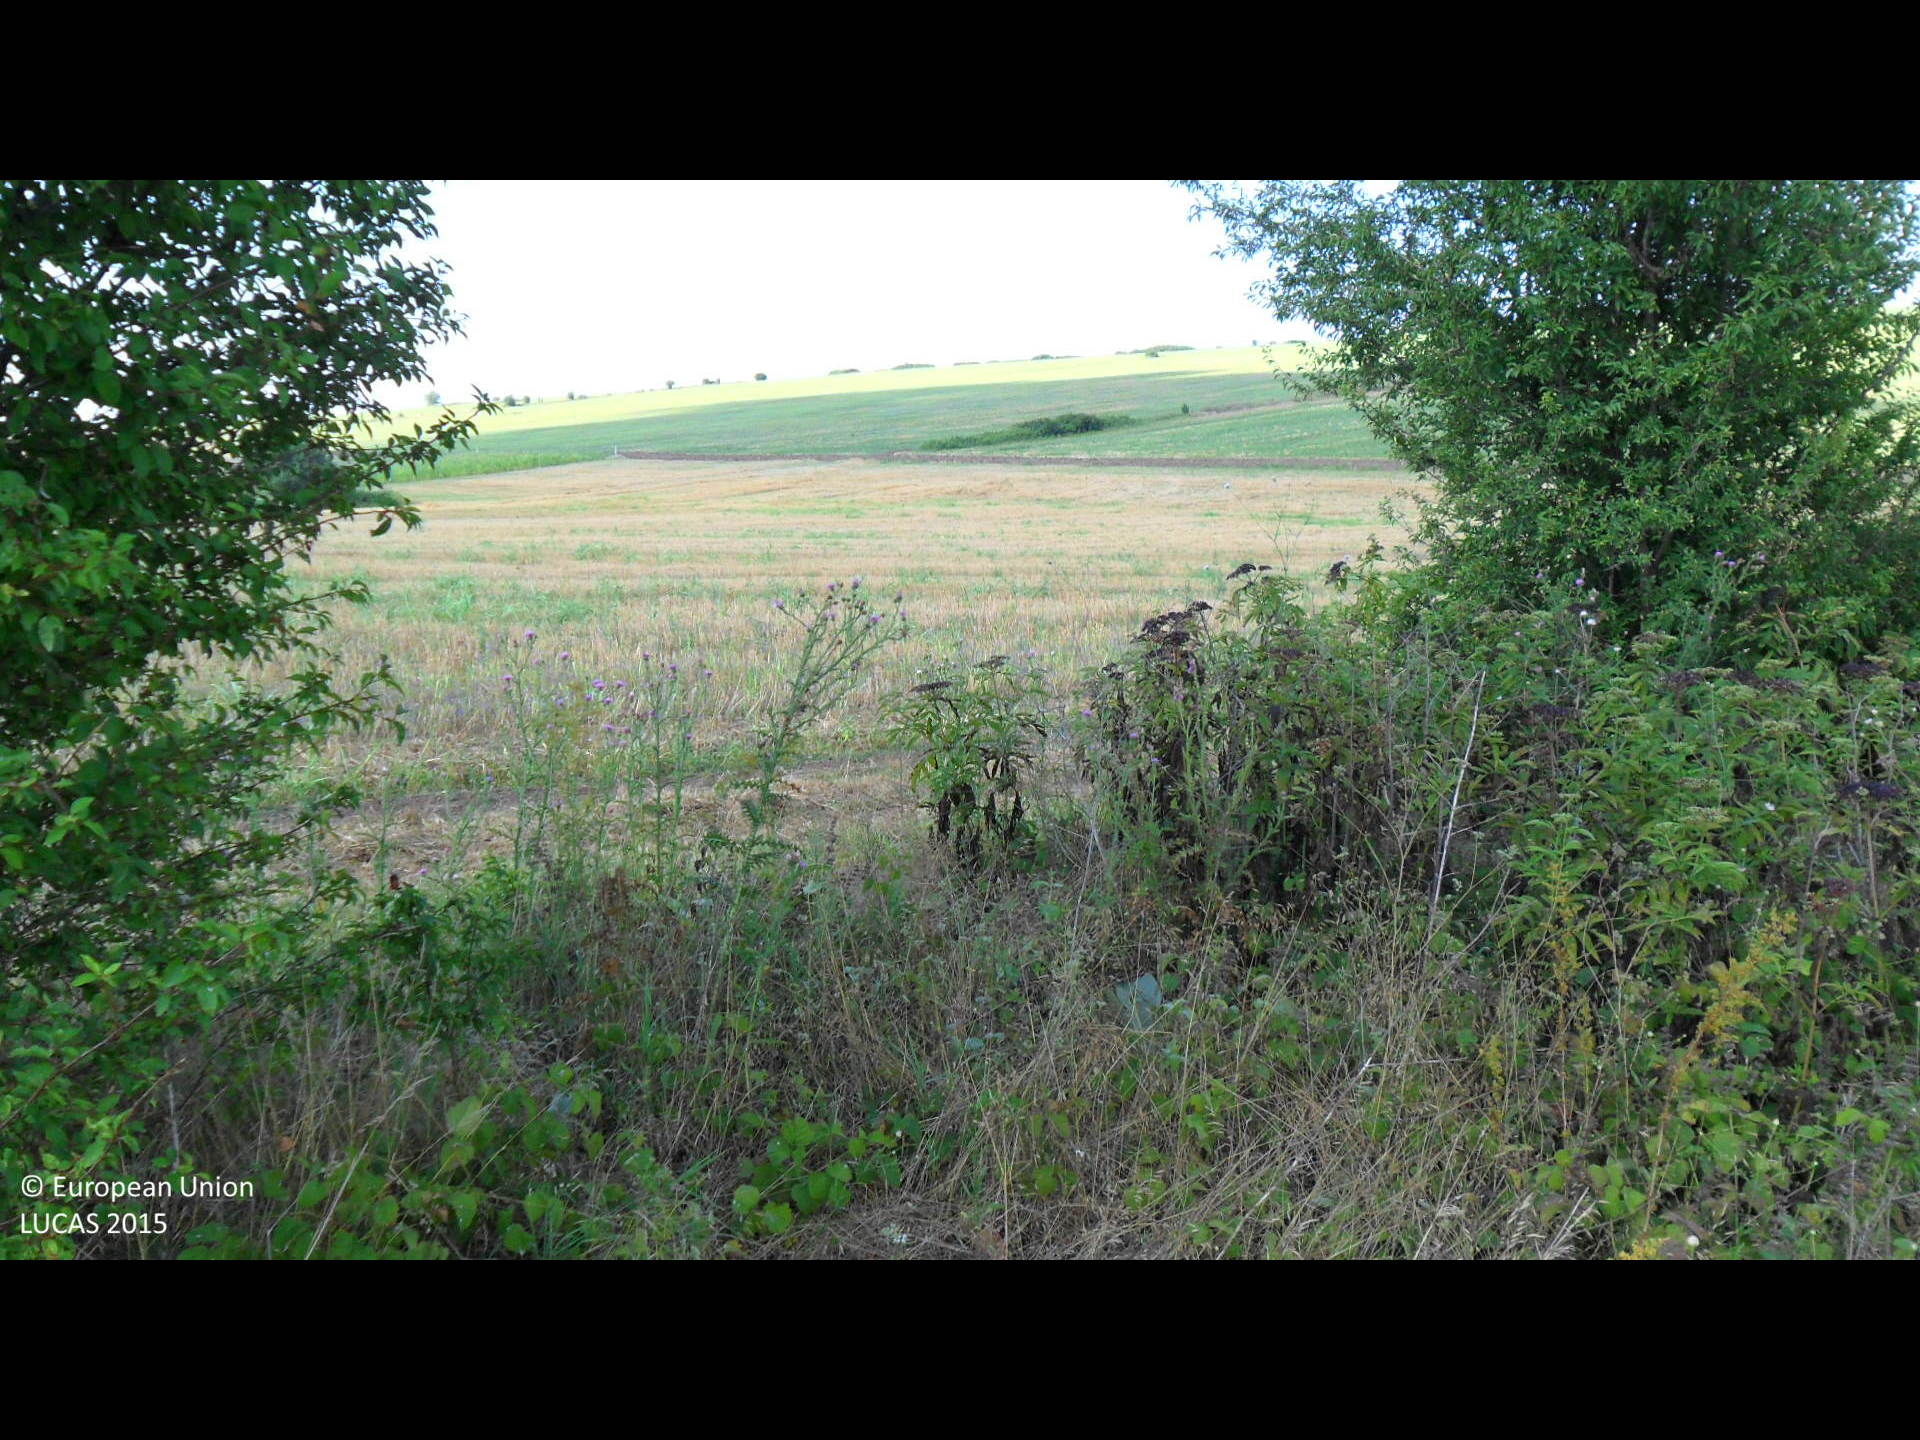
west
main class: Cropland
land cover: Sunflower
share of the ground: > 75 %
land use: Agriculture (excluding fallow land and kitchen gardens)
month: August
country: BG
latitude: 43.3987
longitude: 26.3102
